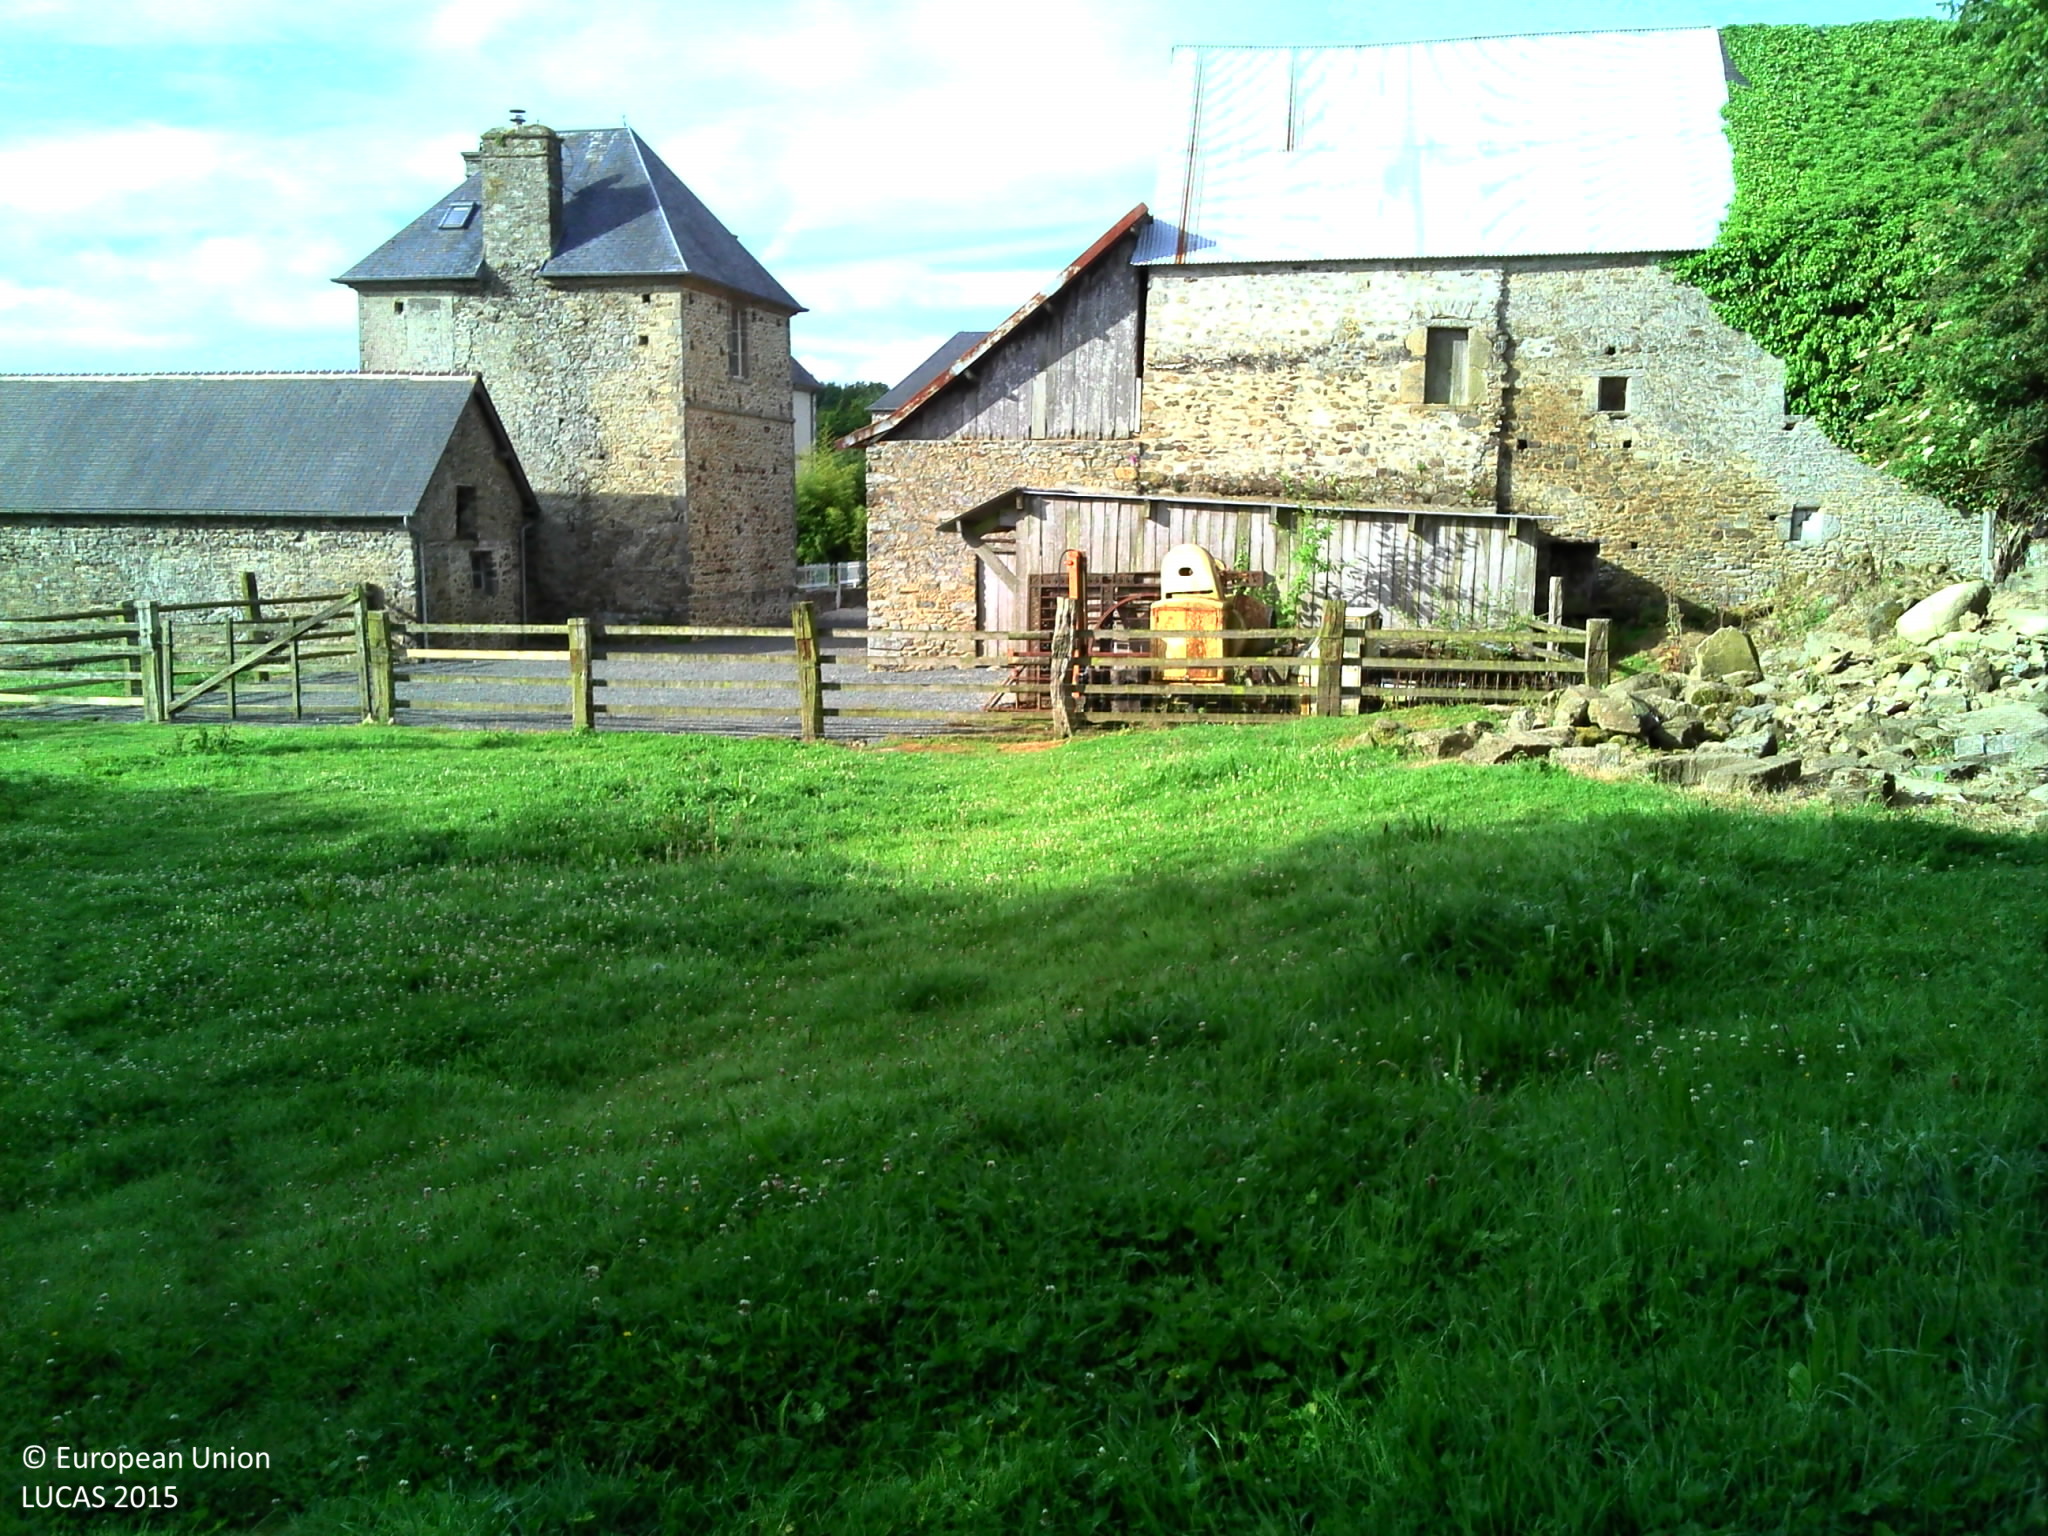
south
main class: Grassland
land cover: Grassland without tree/shrub cover
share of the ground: > 75 %
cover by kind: herbaceous plants 100 %
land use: Agriculture (excluding fallow land and kitchen gardens)
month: June
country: FR
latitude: 49.0782
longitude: -1.4520
